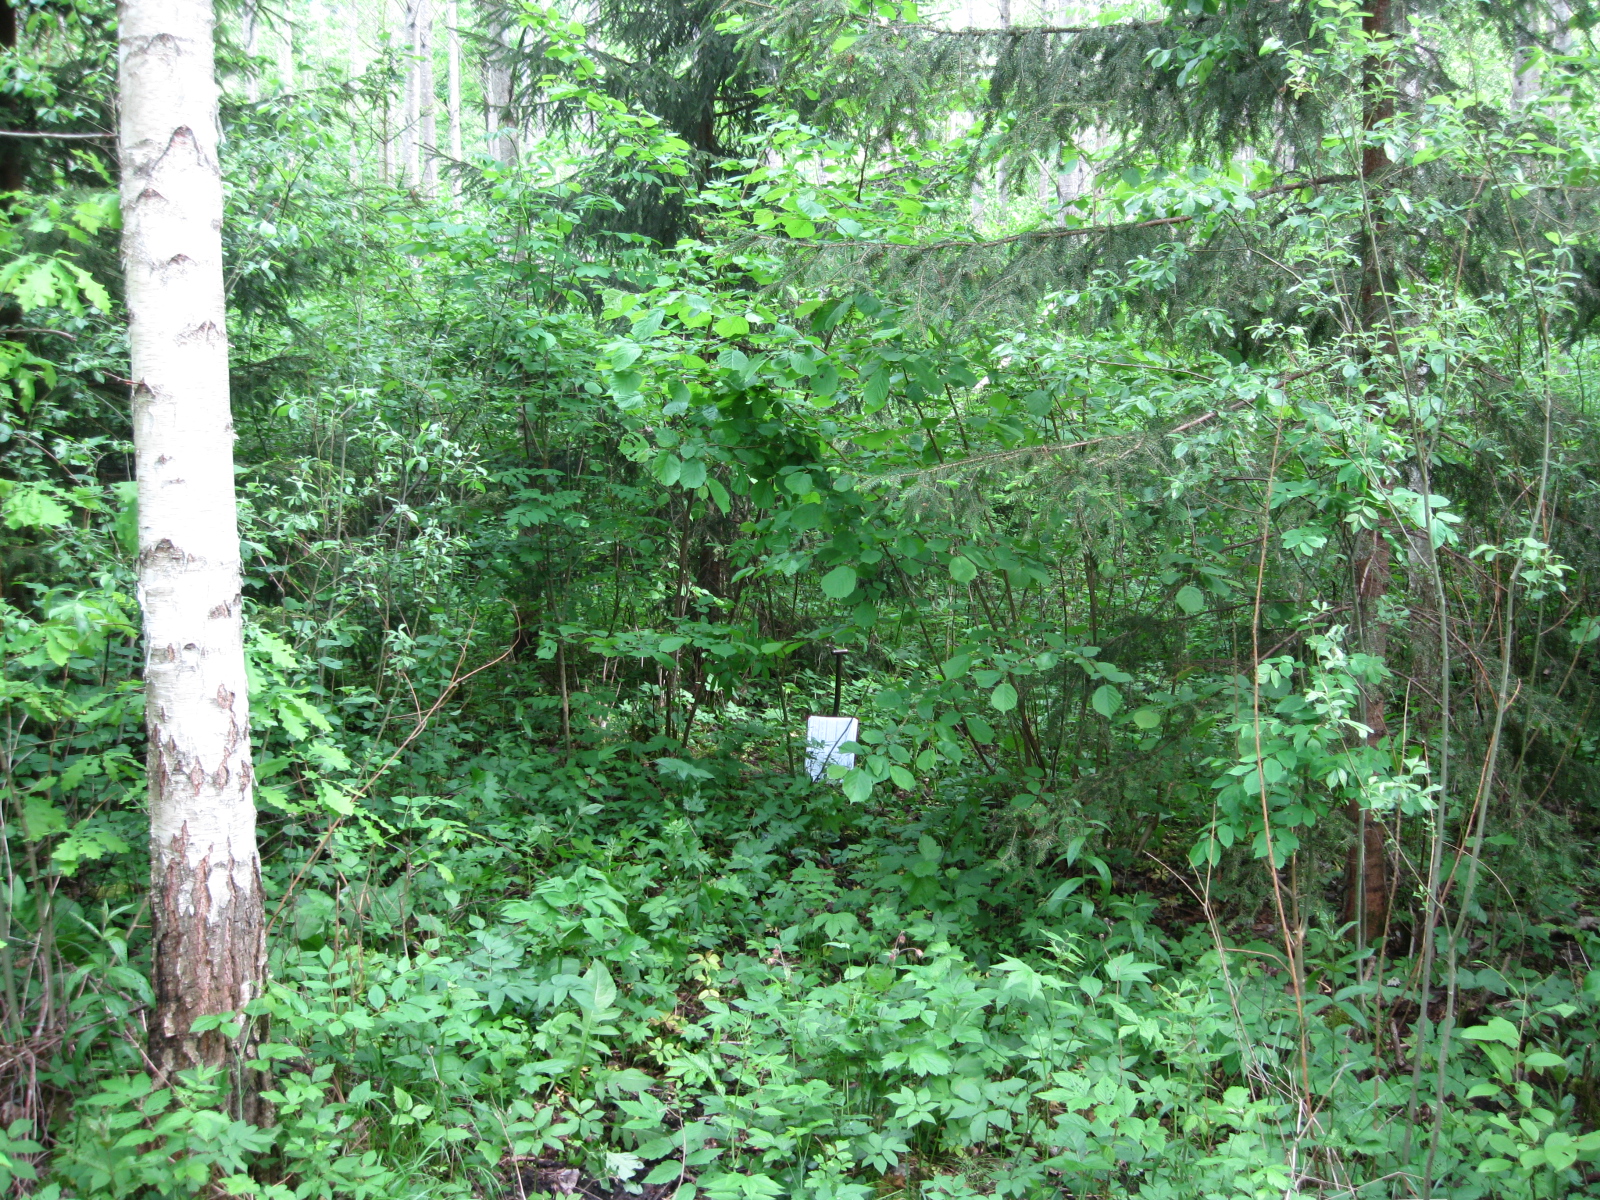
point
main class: Woodland
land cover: Spruce dominated mixed woodland
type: hemiboreal forest and nemoral coniferous forest and mixed broadleaved-coniferous forest
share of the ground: > 75 %
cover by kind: coniferous forest trees 40 %, broadleaved forest trees 40 %, herbaceous plants 15 %, shrubs 5 %
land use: Forestry
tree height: > 5 m
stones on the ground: < 10 %
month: June
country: LT
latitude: 55.9625
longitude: 24.0083
